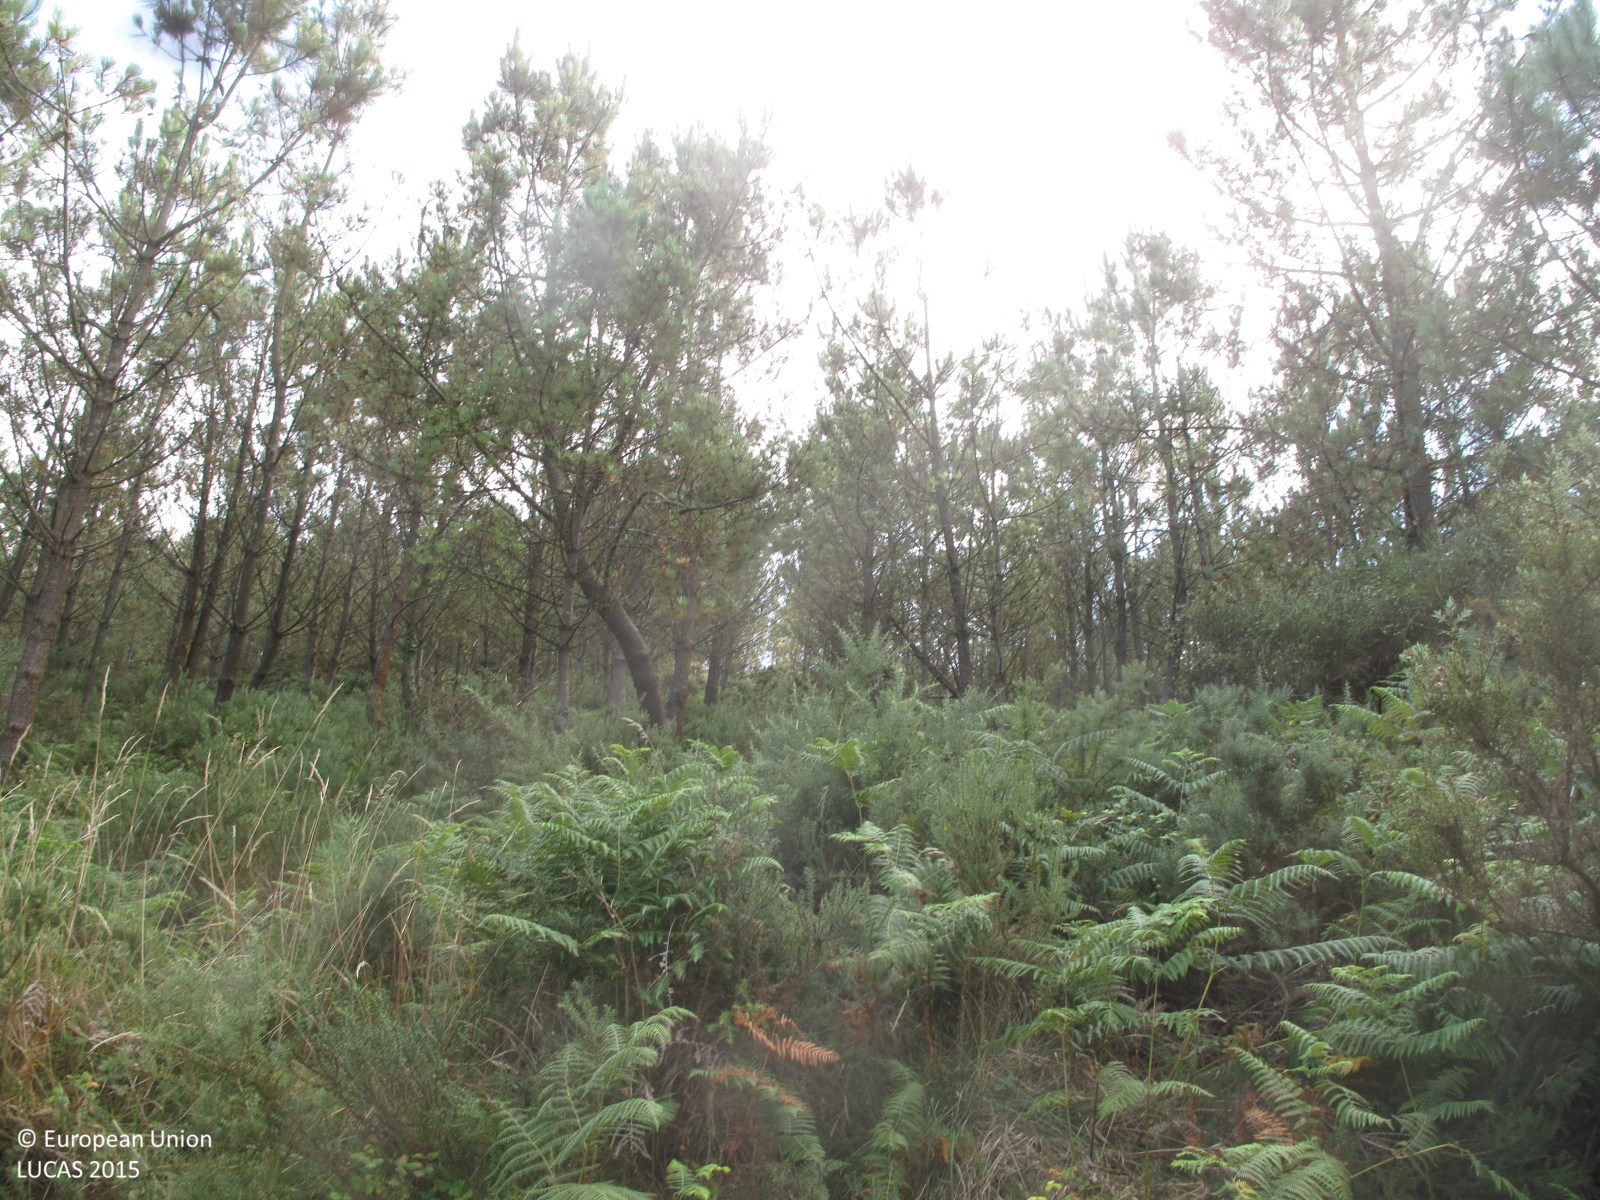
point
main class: Woodland
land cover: Pine dominated coniferous woodland
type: hemiboreal forest and nemoral coniferous forest and mixed broadleaved-coniferous forest
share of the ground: 50 - 75 %
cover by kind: coniferous forest trees 60 %, shrubs 20 %, herbaceous plants 20 %
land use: Forestry
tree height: > 5 m
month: July
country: ES
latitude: 42.9602
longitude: -9.1133
